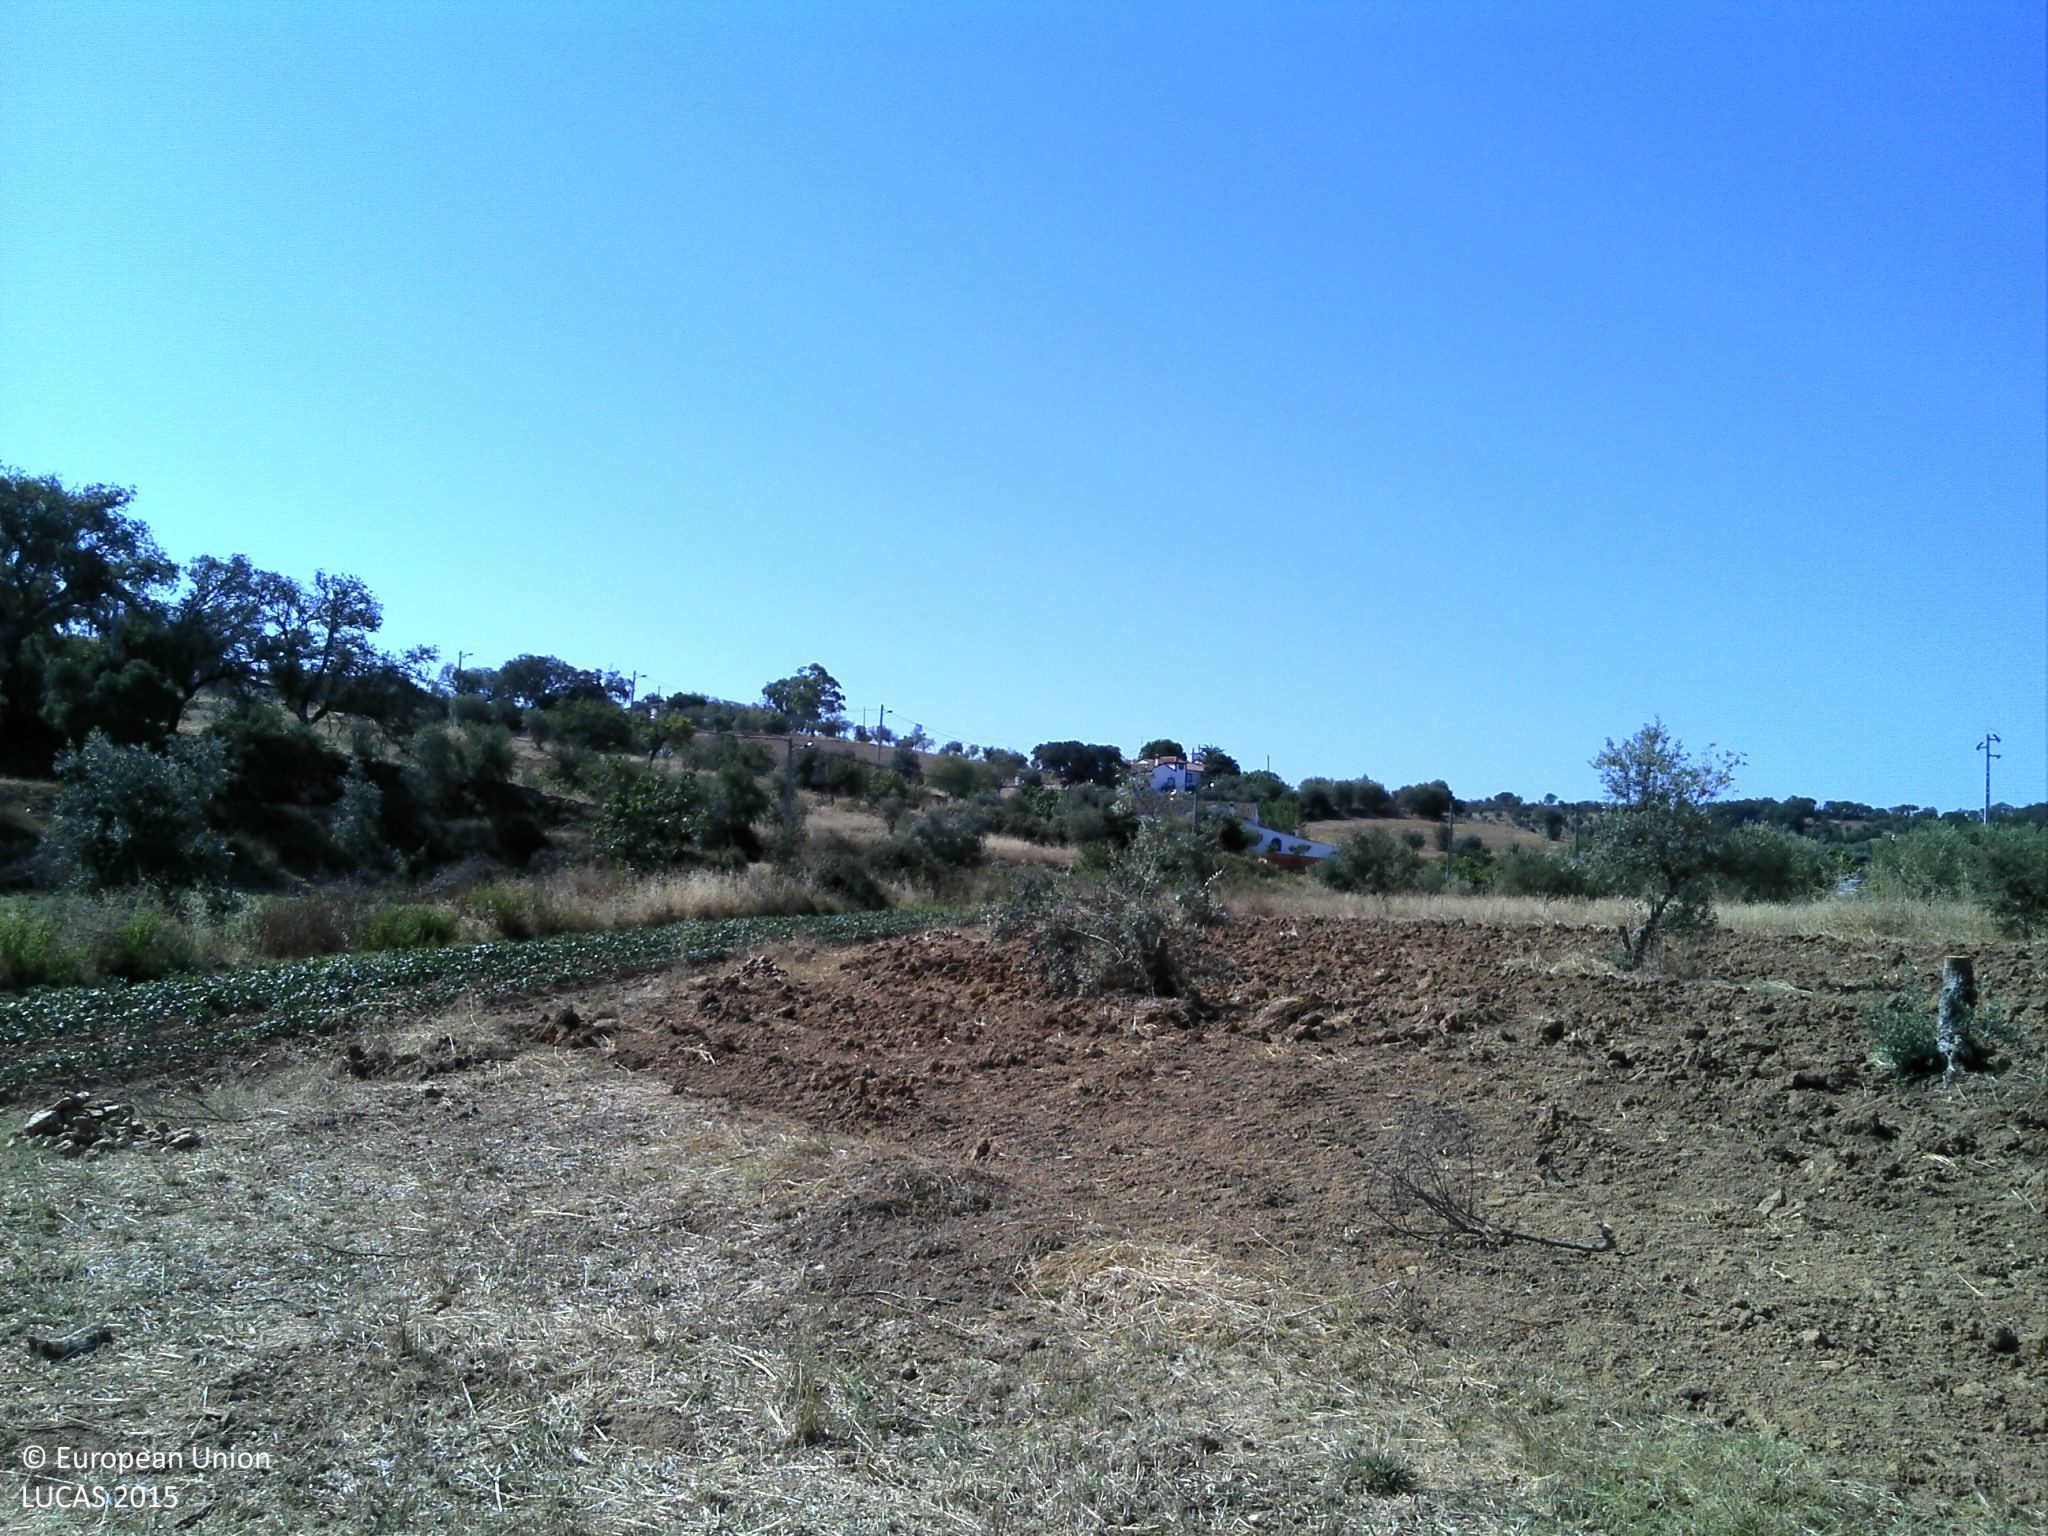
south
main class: Cropland
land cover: Olive groves
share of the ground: 10 - 25 %
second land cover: Oats
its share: < 10 %
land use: Agriculture (excluding fallow land and kitchen gardens)
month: July
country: PT
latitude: 38.5328
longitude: -7.5004
